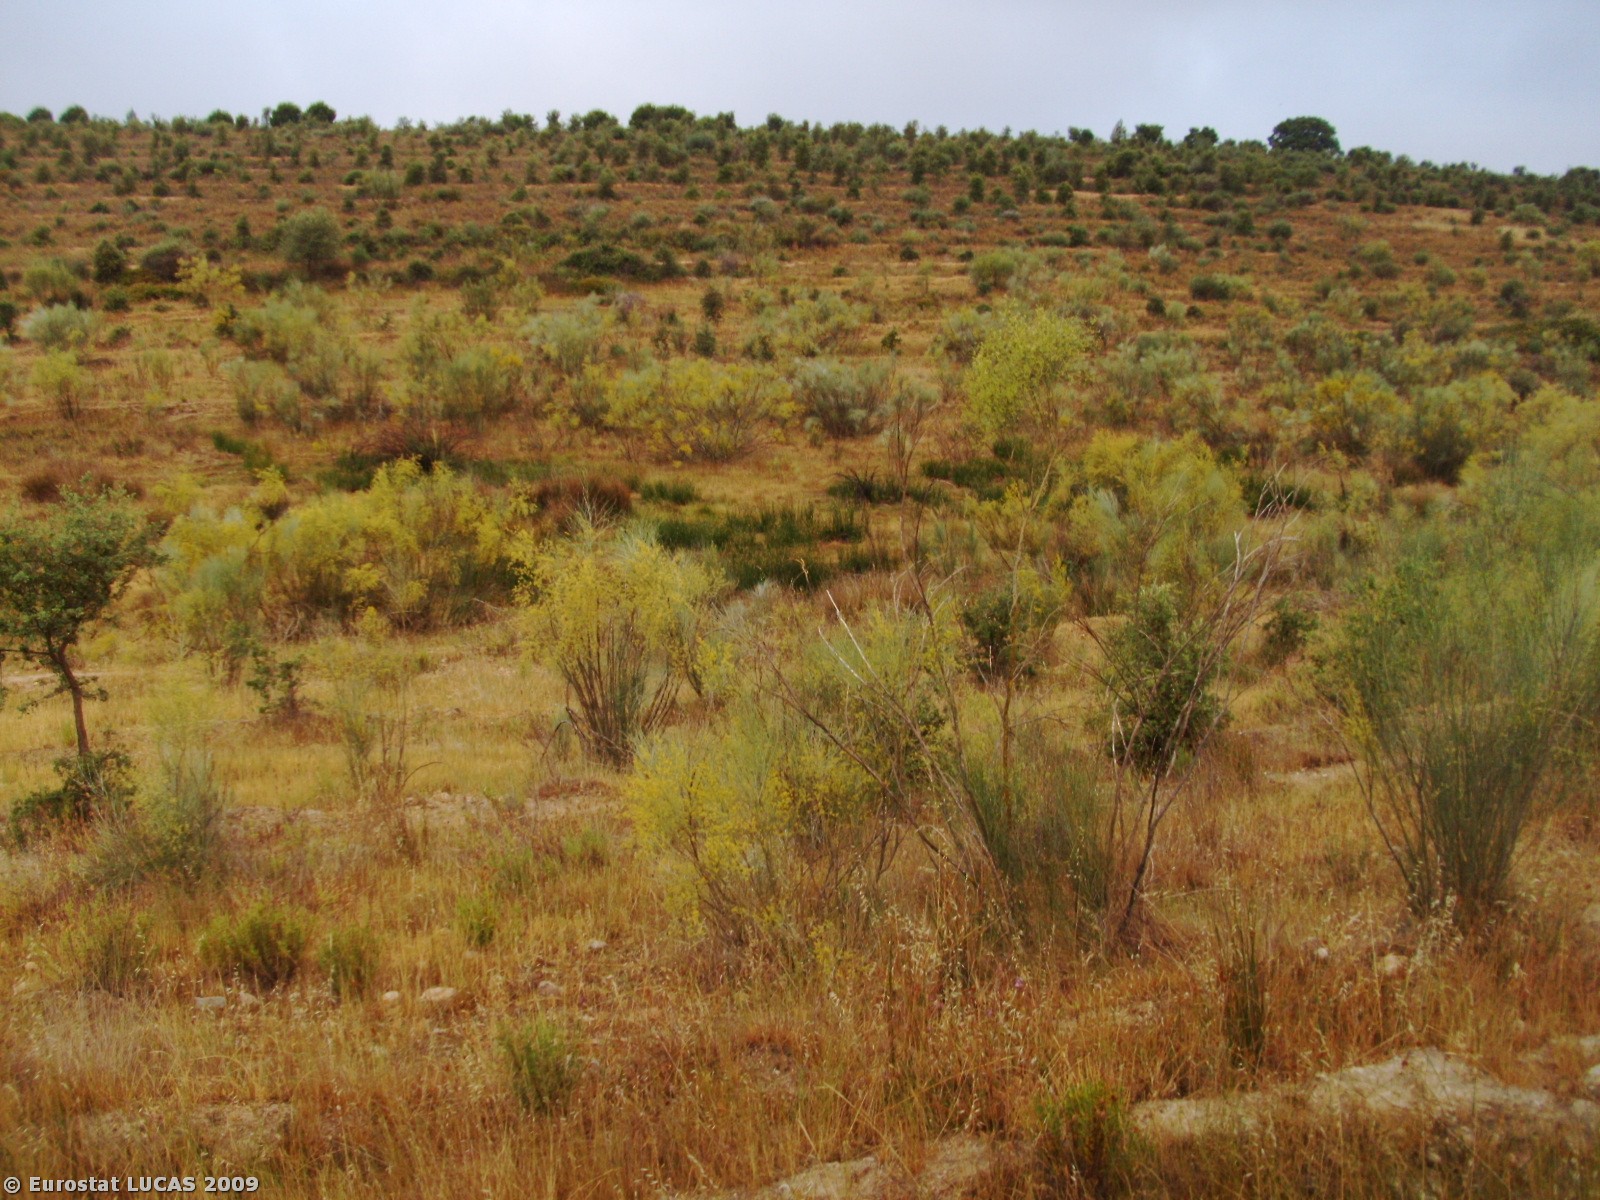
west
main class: Woodland
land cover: Broadleaved woodland
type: broadleaved evergreen forest
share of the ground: 25 - 50 %
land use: Forestry
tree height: > 5 m
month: June
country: PT
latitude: 39.7017
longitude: -7.3663
